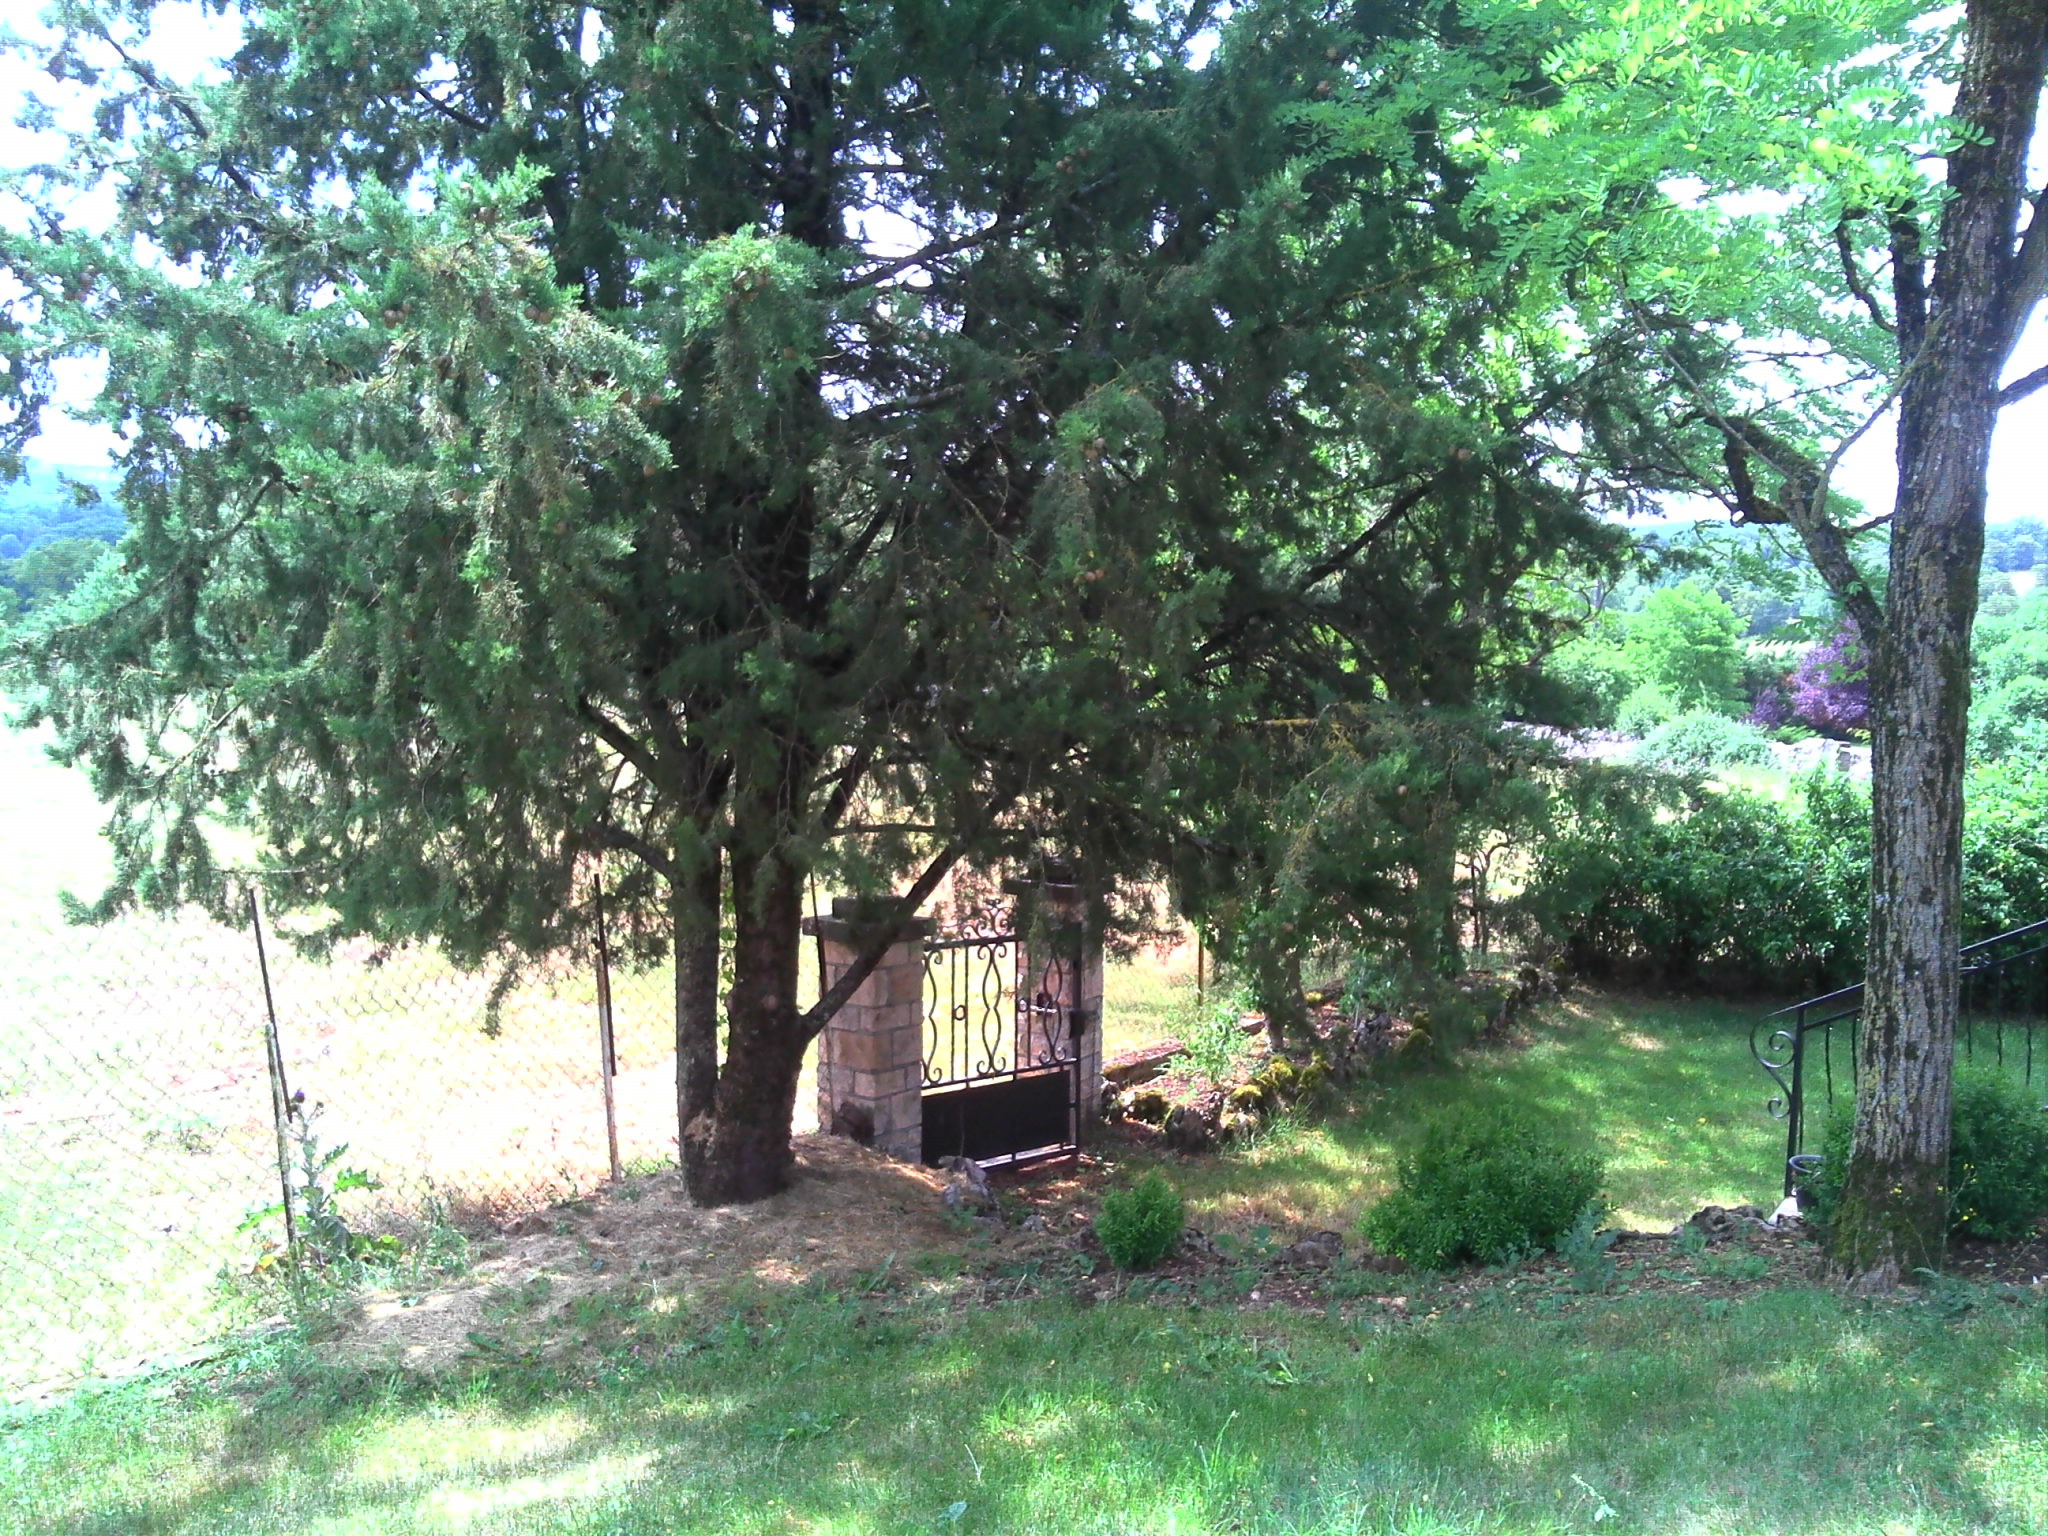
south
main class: Grassland
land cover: Grassland without tree/shrub cover
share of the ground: > 75 %
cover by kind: herbaceous plants 100 %
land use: Residential
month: June
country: FR
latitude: 44.6251
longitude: 1.8192
